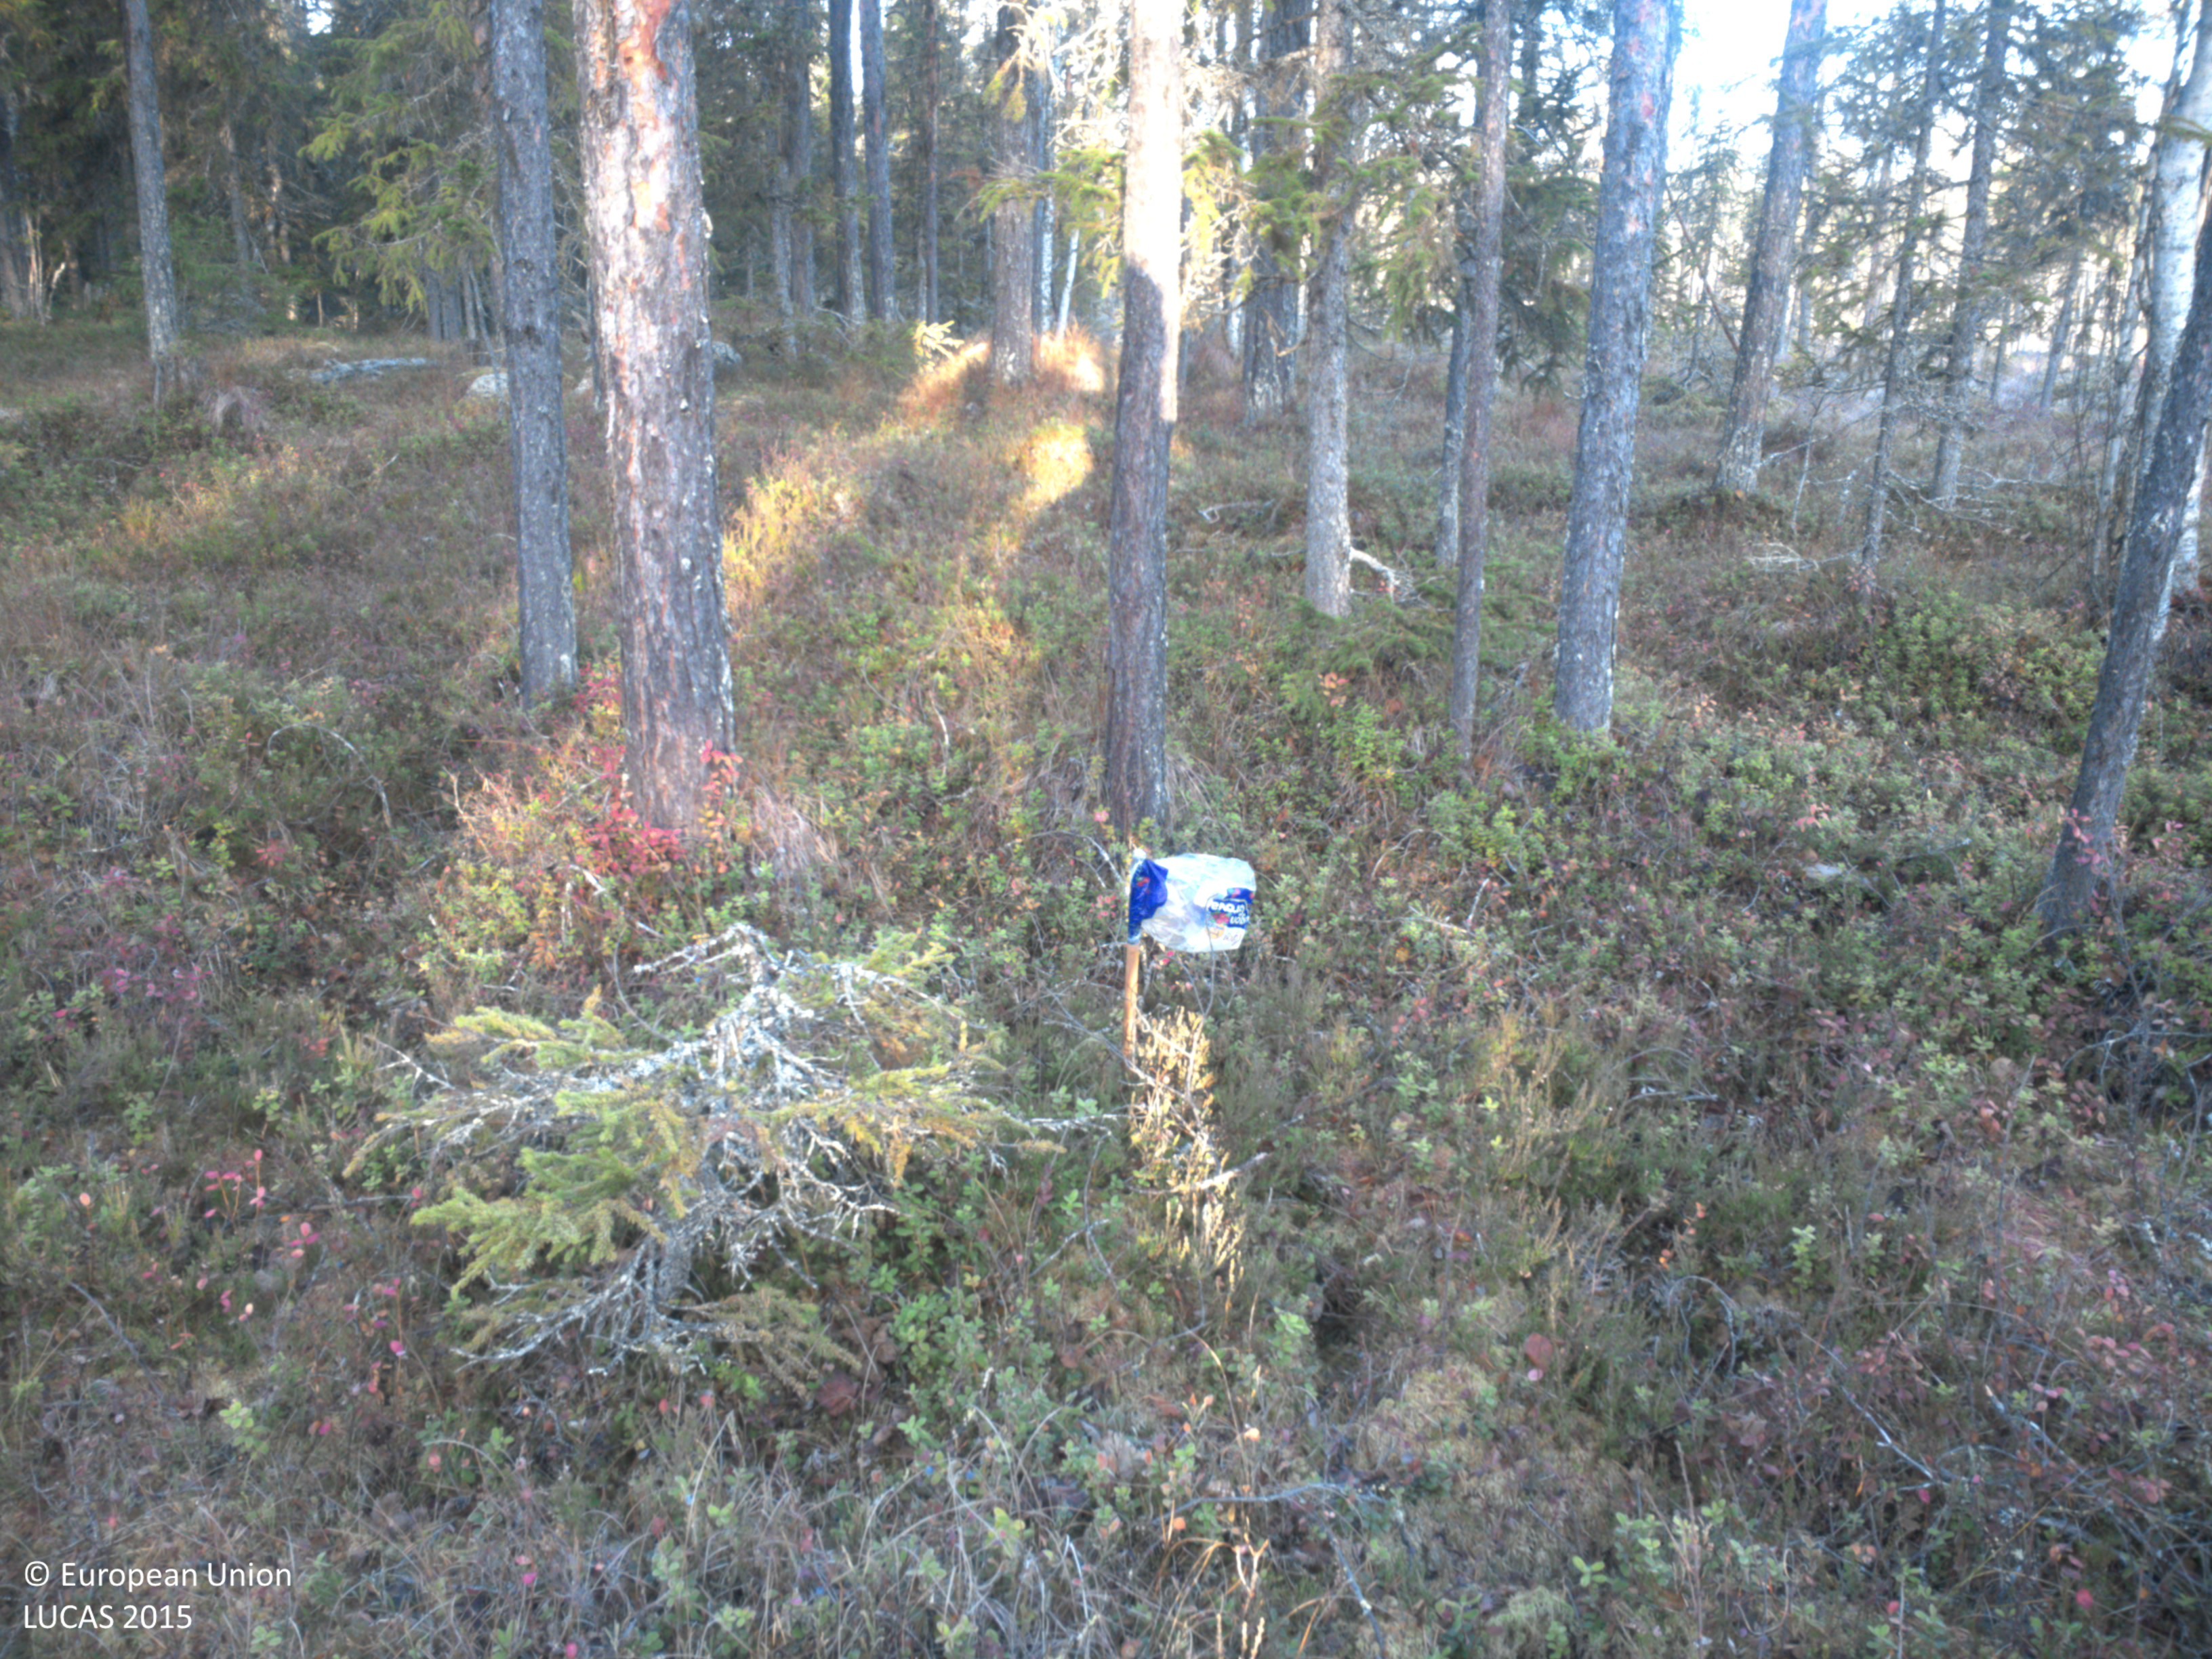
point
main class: Woodland
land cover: Pine dominated mixed woodland
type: boreal forest
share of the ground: 50 - 75 %
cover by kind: coniferous forest trees 35 %, shrubs 30 %, broadleaved forest trees 15 %, herbaceous plants 15 %, lichens and mosses 5 %
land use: Forestry
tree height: > 5 m
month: October
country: SE
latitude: 64.8177
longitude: 18.2854
